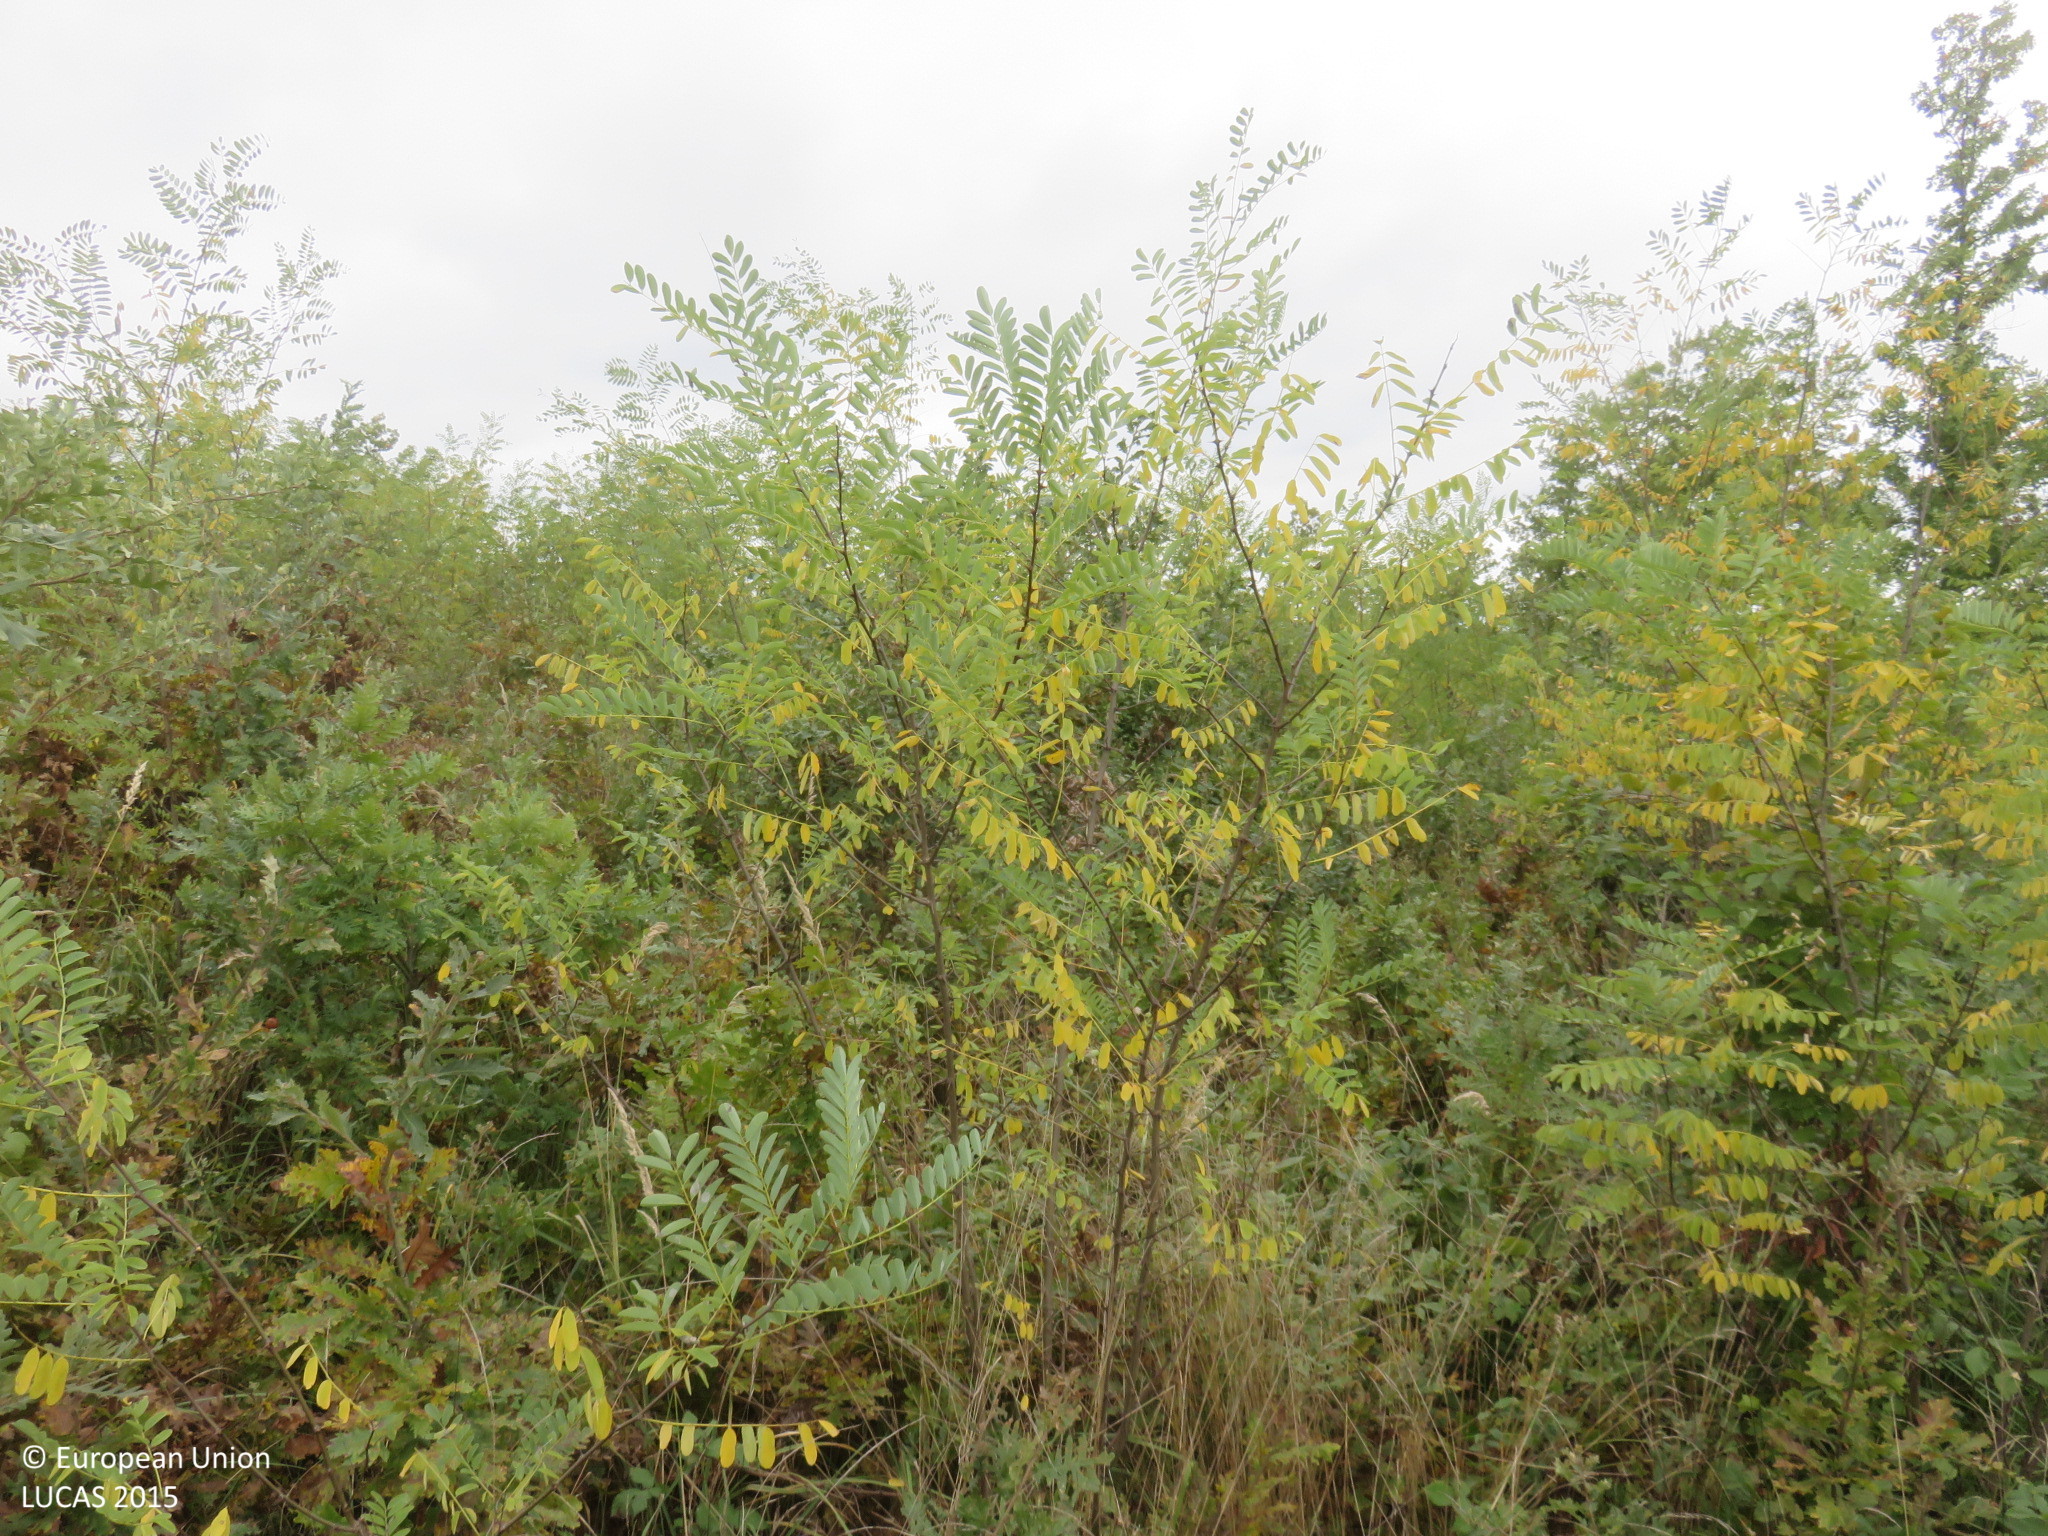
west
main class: Woodland
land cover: Broadleaved woodland
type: mesophytic deciduous forest
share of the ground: > 75 %
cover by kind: shrubs 75 %, broadleaved forest trees 25 %
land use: Forestry
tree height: < 5 m
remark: Clear cut
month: October
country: BG
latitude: 43.0037
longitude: 25.1956
